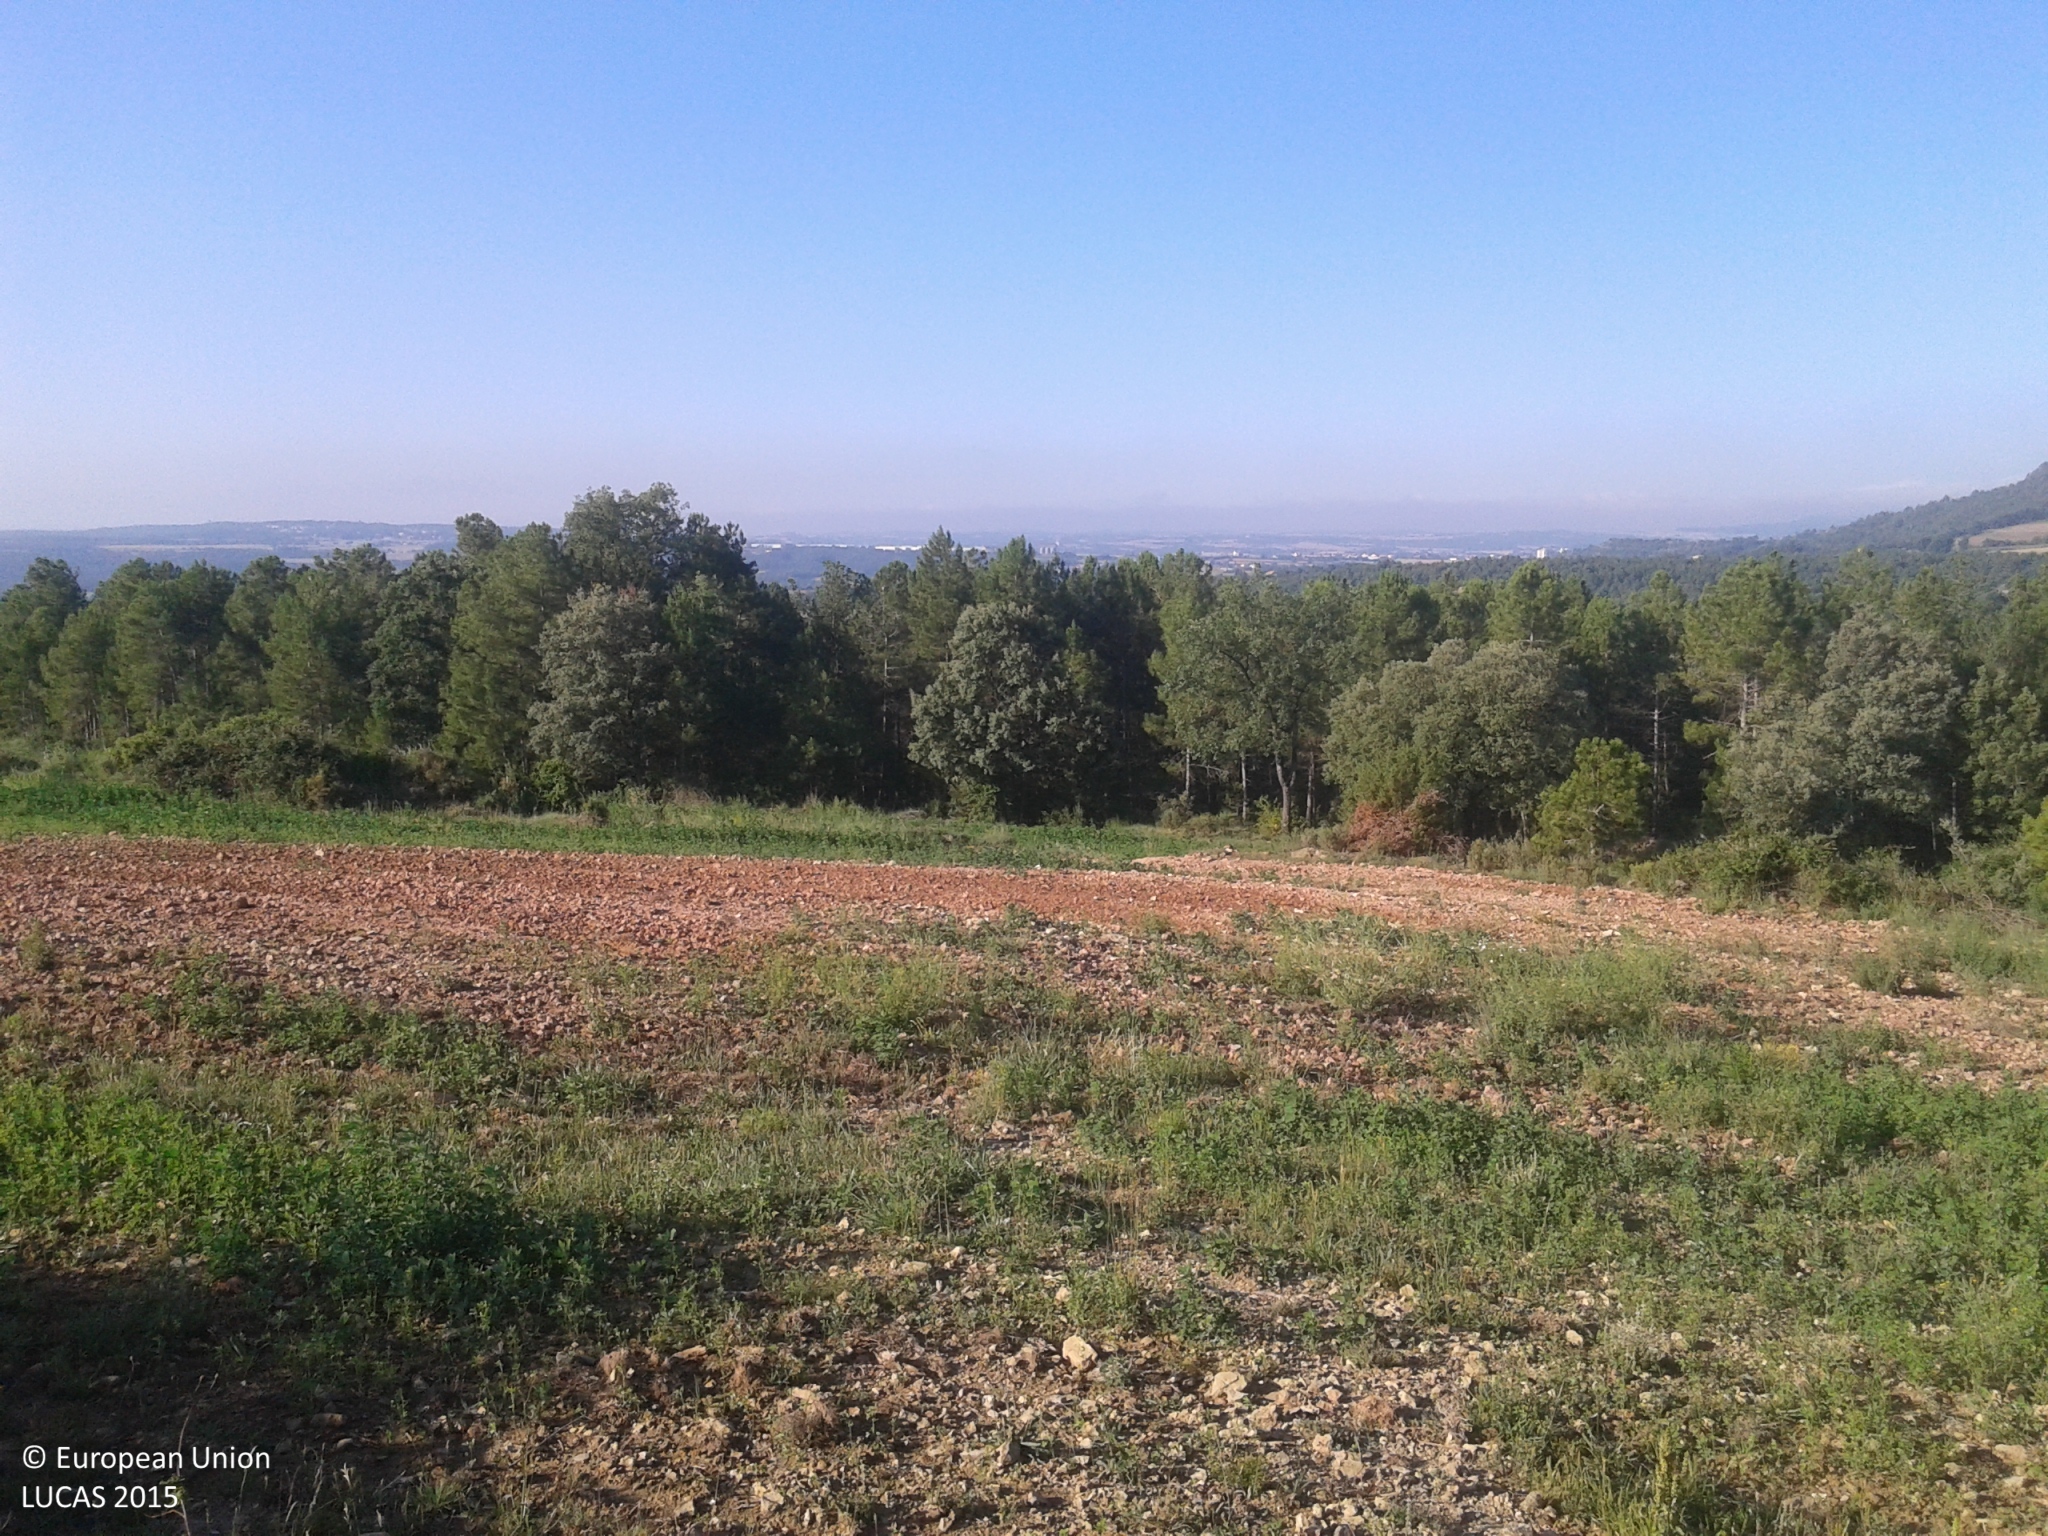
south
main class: Cropland
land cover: Temporary grasslands
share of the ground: > 75 %
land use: Agriculture (excluding fallow land and kitchen gardens)
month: June
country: ES
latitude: 42.0278
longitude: 1.5457
